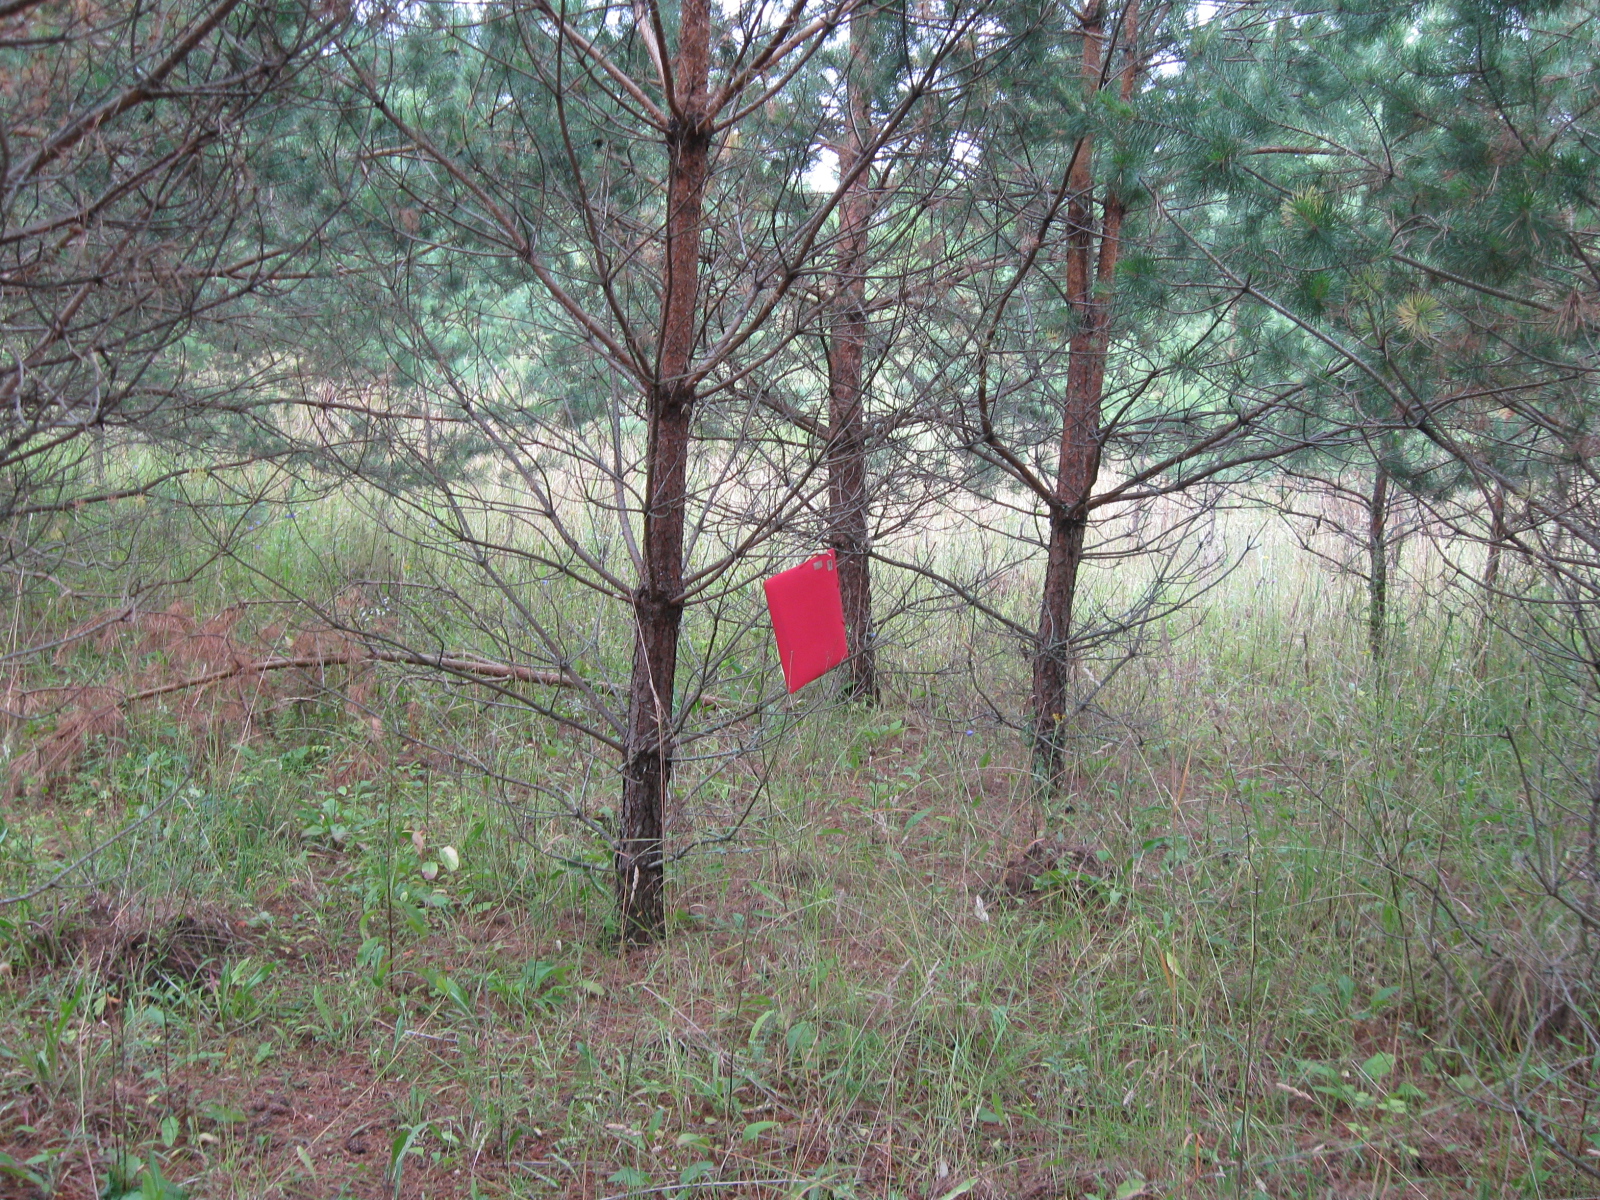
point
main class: Woodland
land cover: Pine dominated coniferous woodland
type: hemiboreal forest and nemoral coniferous forest and mixed broadleaved-coniferous forest
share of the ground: 50 - 75 %
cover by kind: coniferous forest trees 70 %, herbaceous plants 25 %, unconsolidated bare surface 5 %
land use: Forestry
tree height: < 5 m
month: July
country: LT
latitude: 54.4058
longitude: 24.3504
